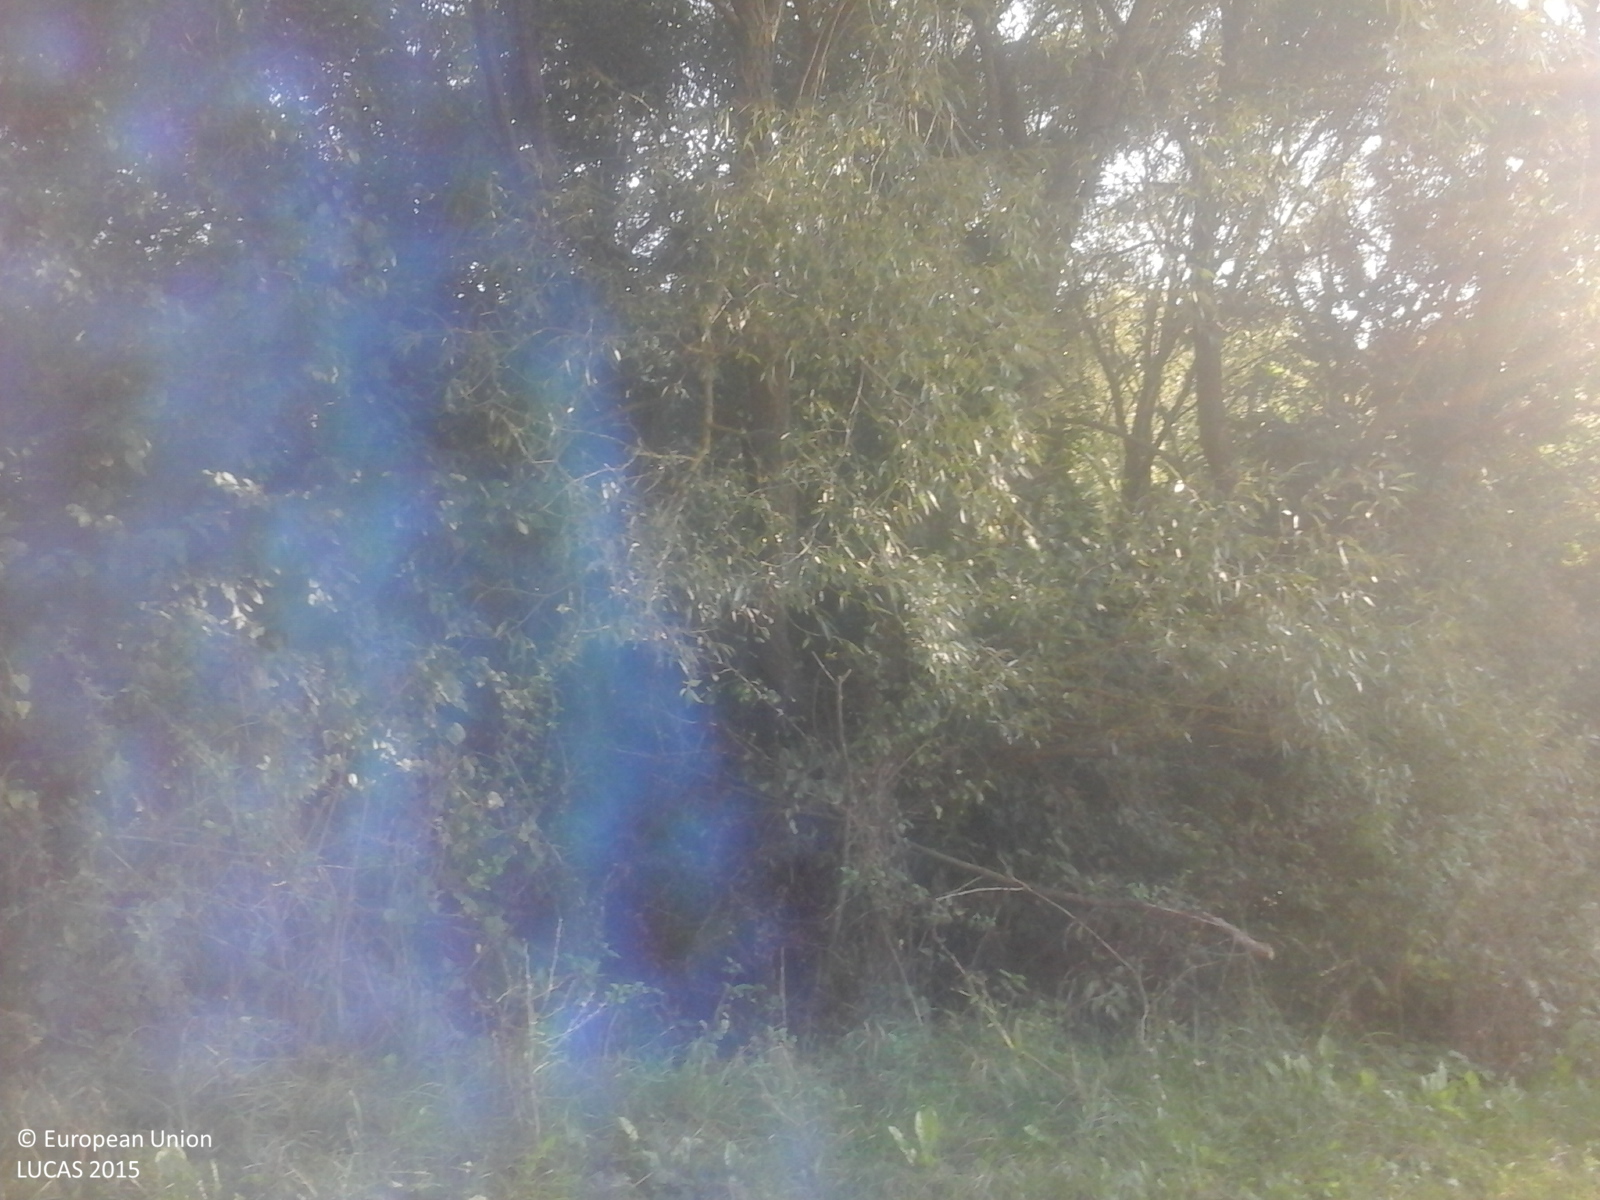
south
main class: Woodland
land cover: Broadleaved woodland
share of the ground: > 75 %
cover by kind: broadleaved forest trees 100 %
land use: Semi-natural and natural areas not in use
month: September
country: RO
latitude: 46.8867
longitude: 23.2816
